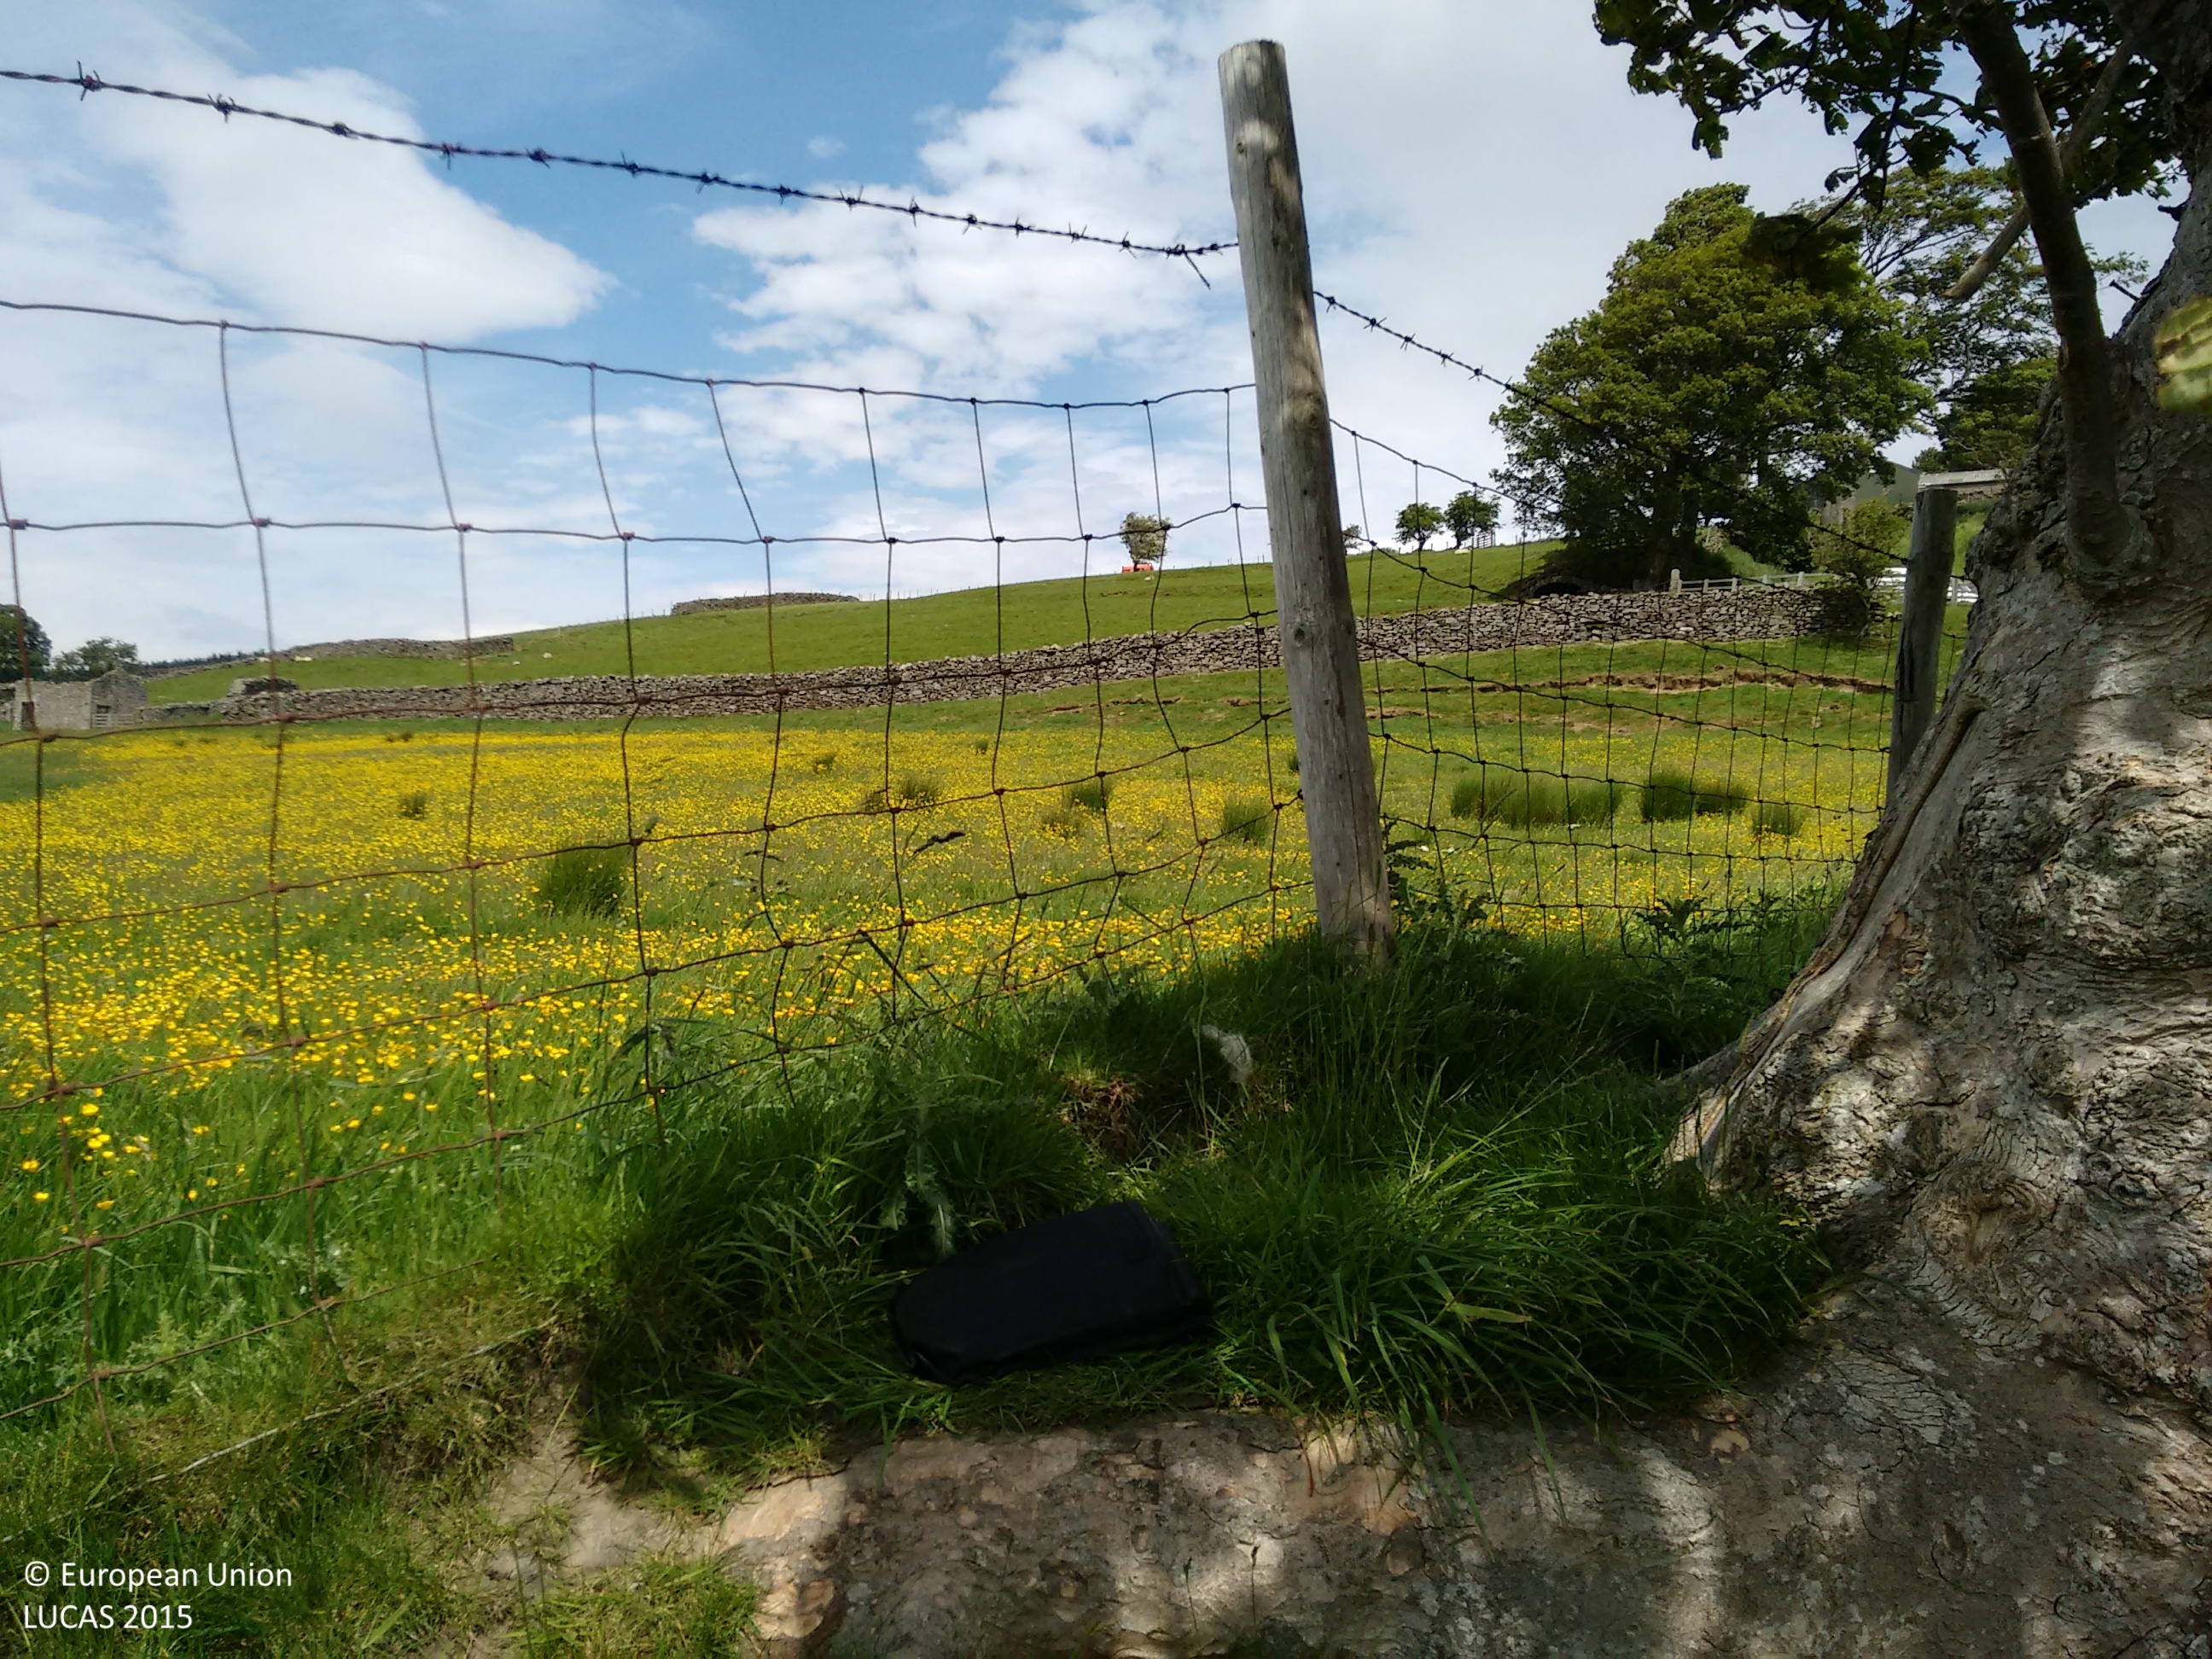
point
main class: Grassland
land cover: Grassland without tree/shrub cover
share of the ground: > 75 %
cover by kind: herbaceous plants 100 %
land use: Agriculture (excluding fallow land and kitchen gardens)
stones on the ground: < 10 %
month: June
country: GB
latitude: 54.1619
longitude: -1.8623
